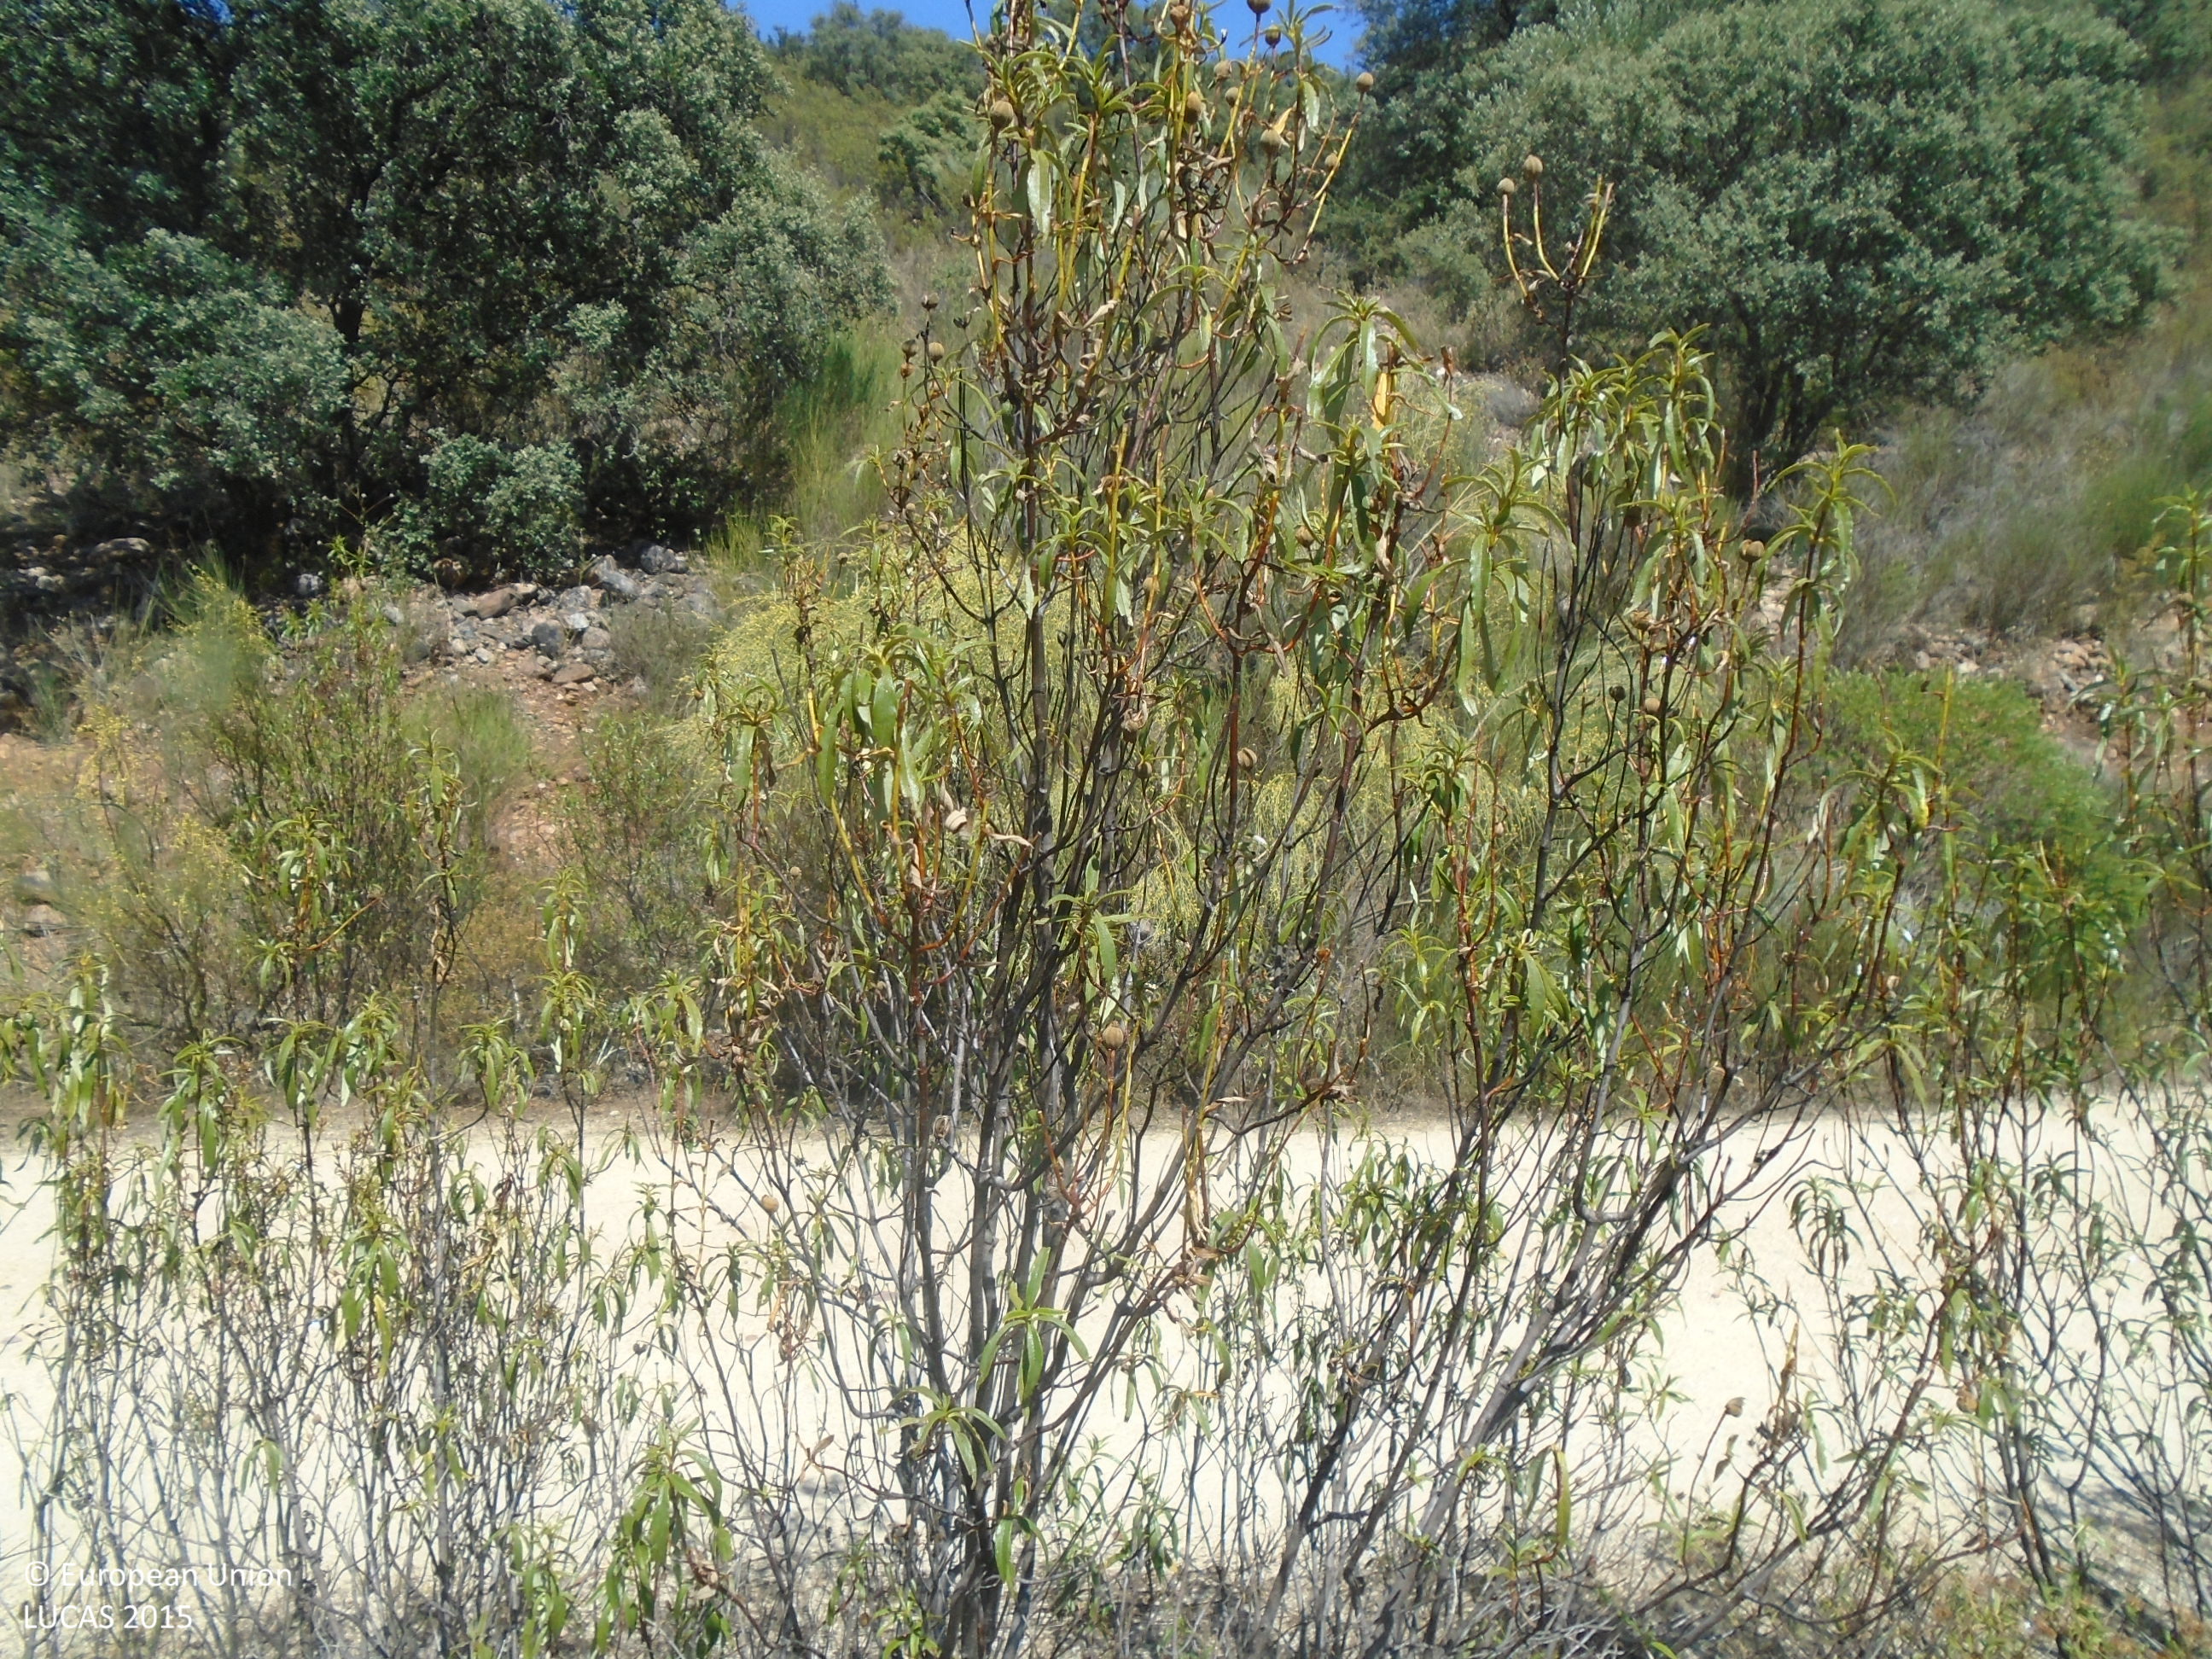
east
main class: Woodland
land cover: Broadleaved woodland
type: broadleaved evergreen forest
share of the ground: > 75 %
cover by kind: broadleaved forest trees 90 %, shrubs 5 %, consolidated bare surface 5 %
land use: Semi-natural and natural areas not in use
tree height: > 5 m
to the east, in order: Broadleaved woodland; Grassland with sparse tree/shrub cover; Rivers and streams; Grassland with sparse tree/shrub cover; Rivers and streams; Grassland with sparse tree/shrub cover; Tracks; Grass margins; Ditches and canals; Grass margins; Grassland with sparse tree/shrub cover
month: July
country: ES
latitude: 39.6933
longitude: -5.0081
